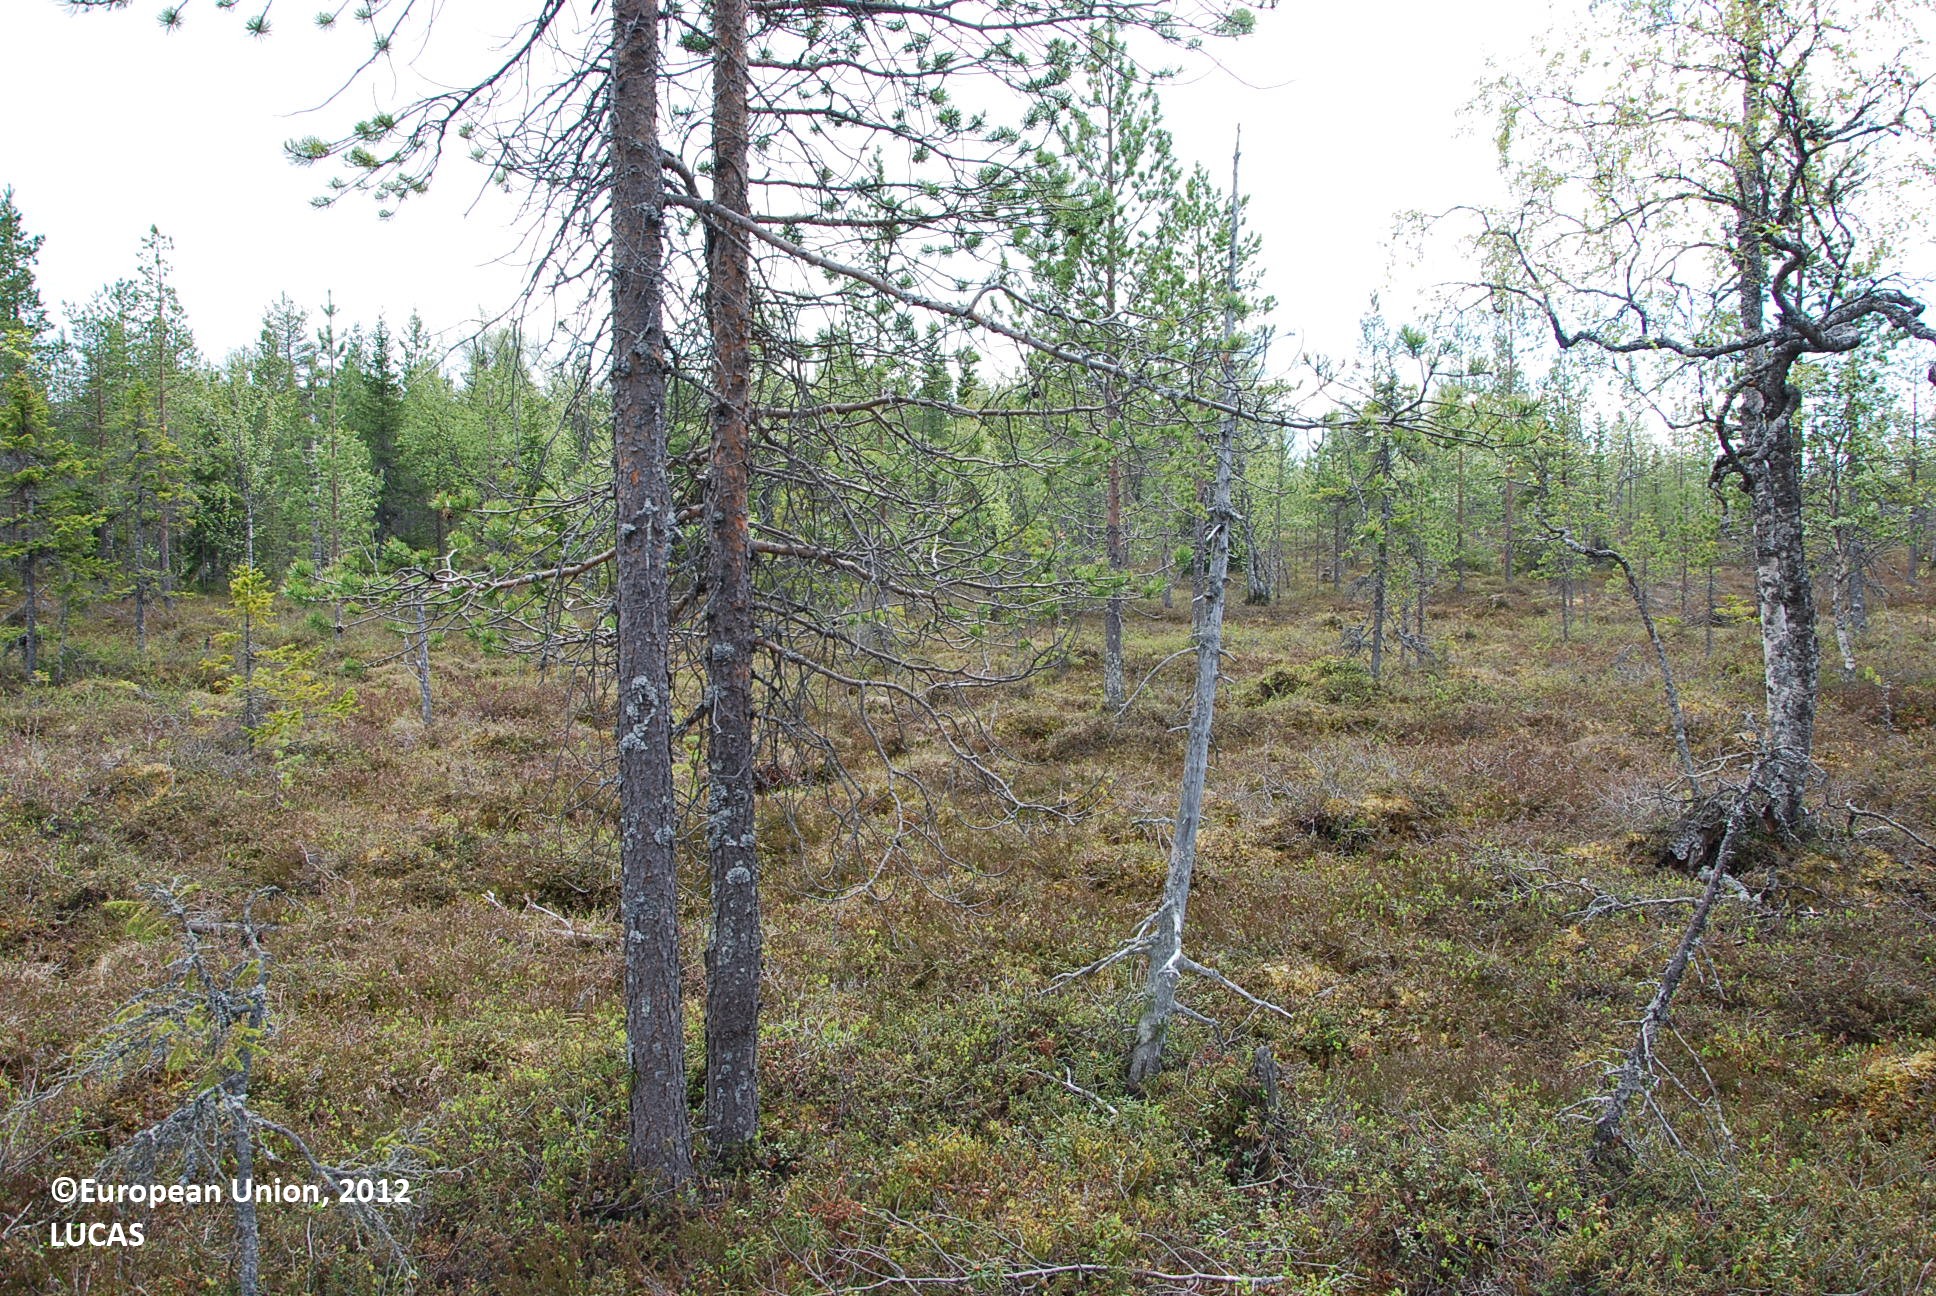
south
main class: Woodland
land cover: Pine dominated mixed woodland
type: boreal forest
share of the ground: 25 - 50 %
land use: Forestry
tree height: > 5 m
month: June
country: FI
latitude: 66.1842
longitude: 27.7253
